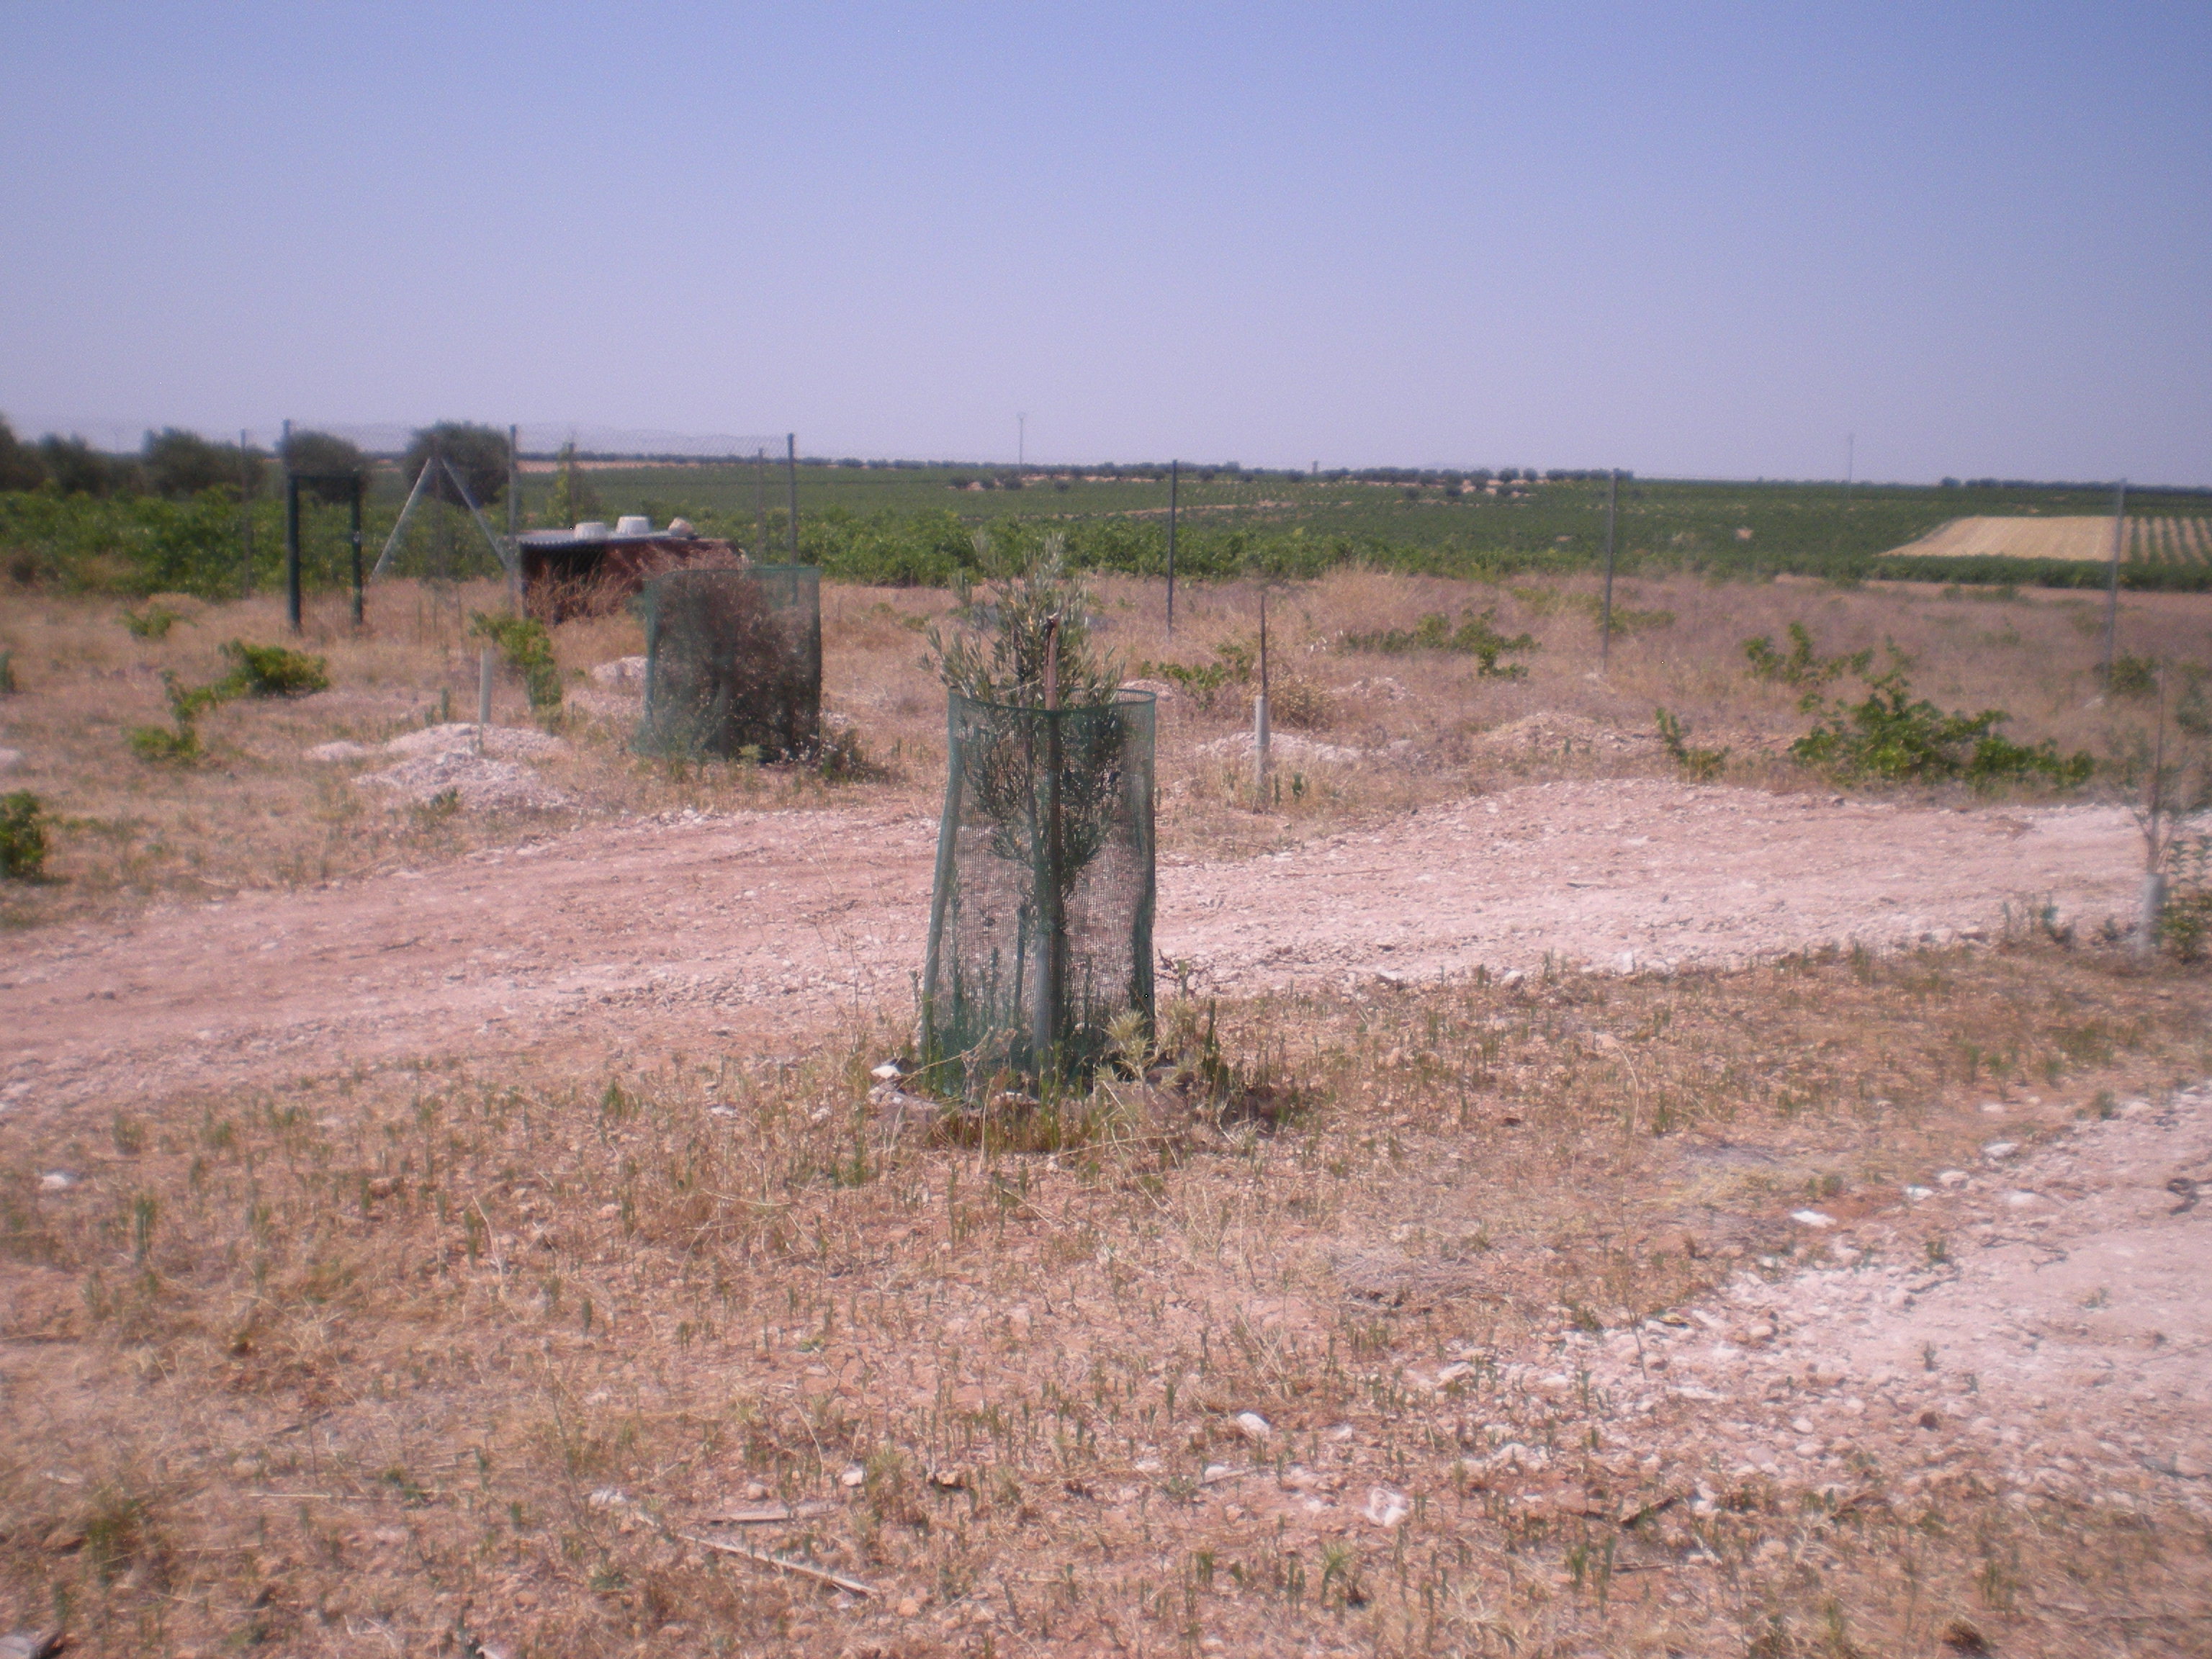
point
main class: Cropland
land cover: Olive groves
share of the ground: < 10 %
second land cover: Spontaneously vegetated surfaces
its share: 10 - 25 %
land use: Agriculture (excluding fallow land and kitchen gardens)
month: July
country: ES
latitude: 39.6047
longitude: -3.0985
